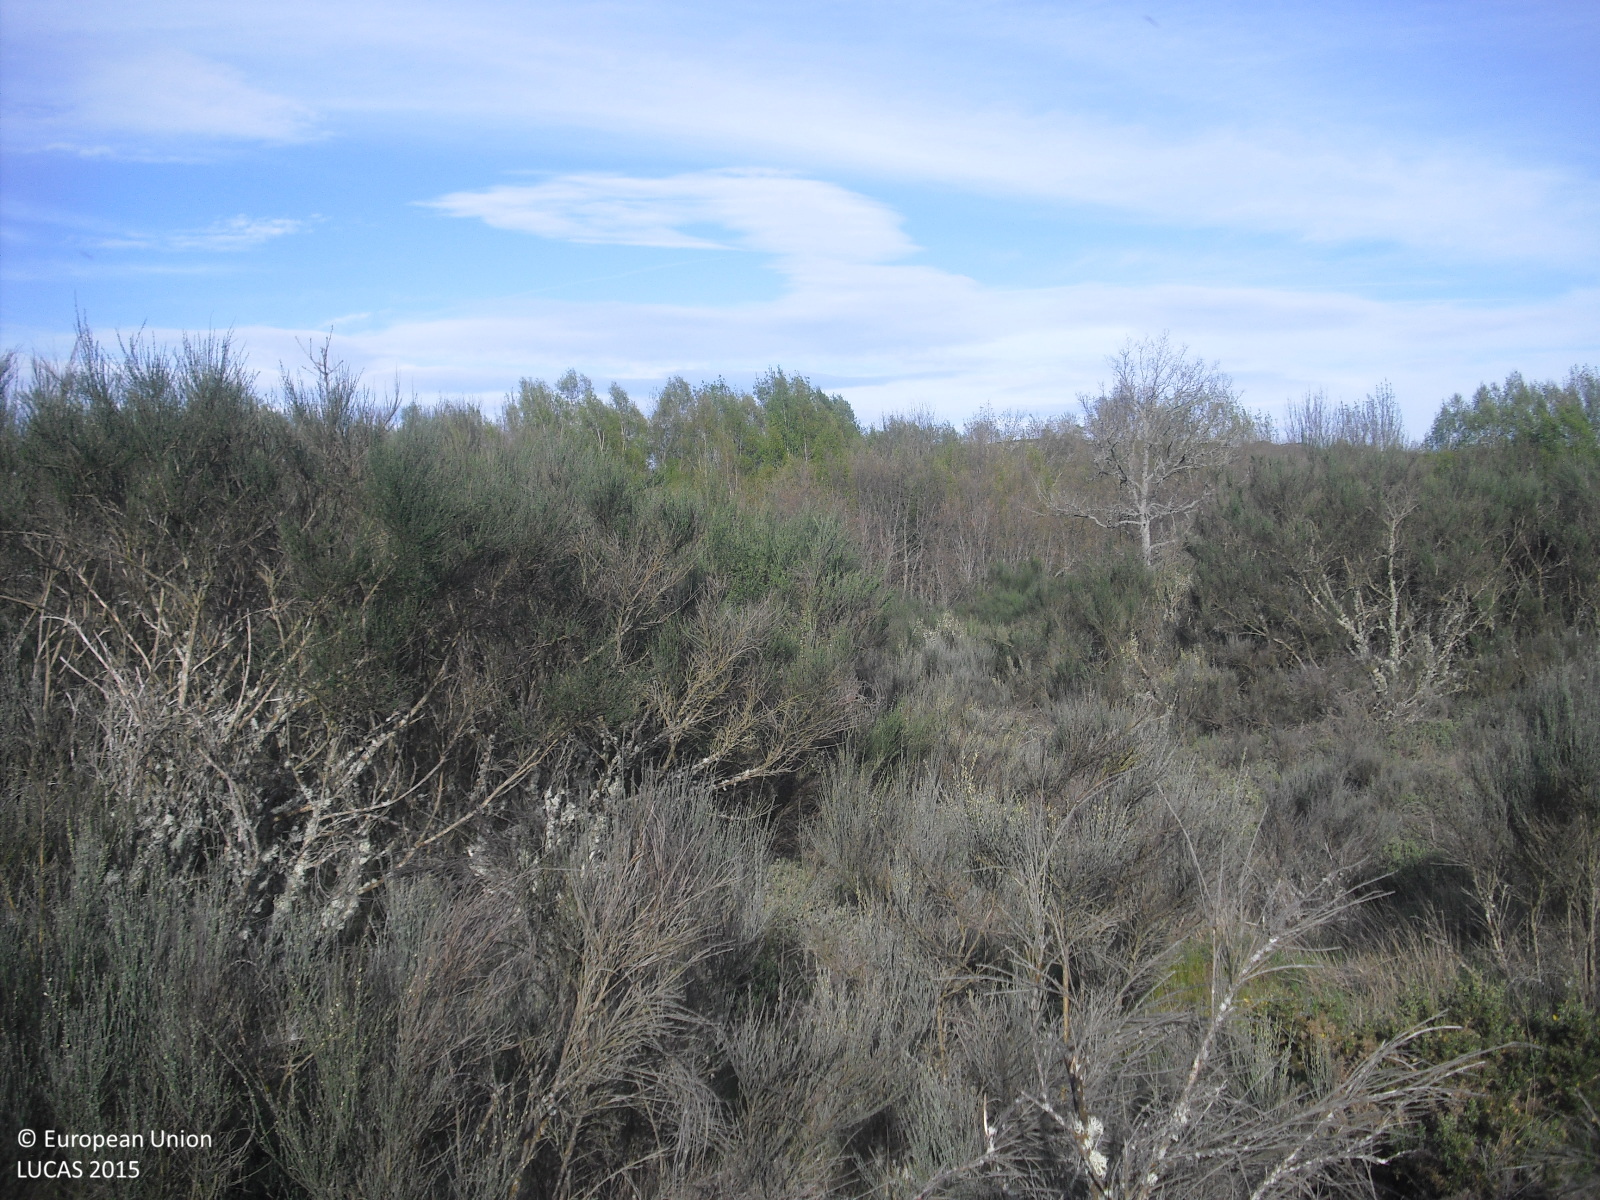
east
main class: Shrubland
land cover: Shrubland without tree cover
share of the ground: > 75 %
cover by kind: shrubs 70 %, herbaceous plants 30 %
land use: Abandoned areas
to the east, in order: Shrubland without tree cover; Broadleaved woodland; Rivers and streams; Broadleaved woodland; Grassland without tree/shrub cover; Broadleaved woodland; Grassland without tree/shrub cover; Electric lines; Grassland without tree/shrub cover; Dry stone walls; Shruby margins; Ditches and canals; Grass margins; Paved roads, cycling and walking lanes; Grass margins; Shruby margins; Dry stone walls; Abandoned hedges; Shrubland without tree cover
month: April
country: ES
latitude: 41.9224
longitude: -7.6337
